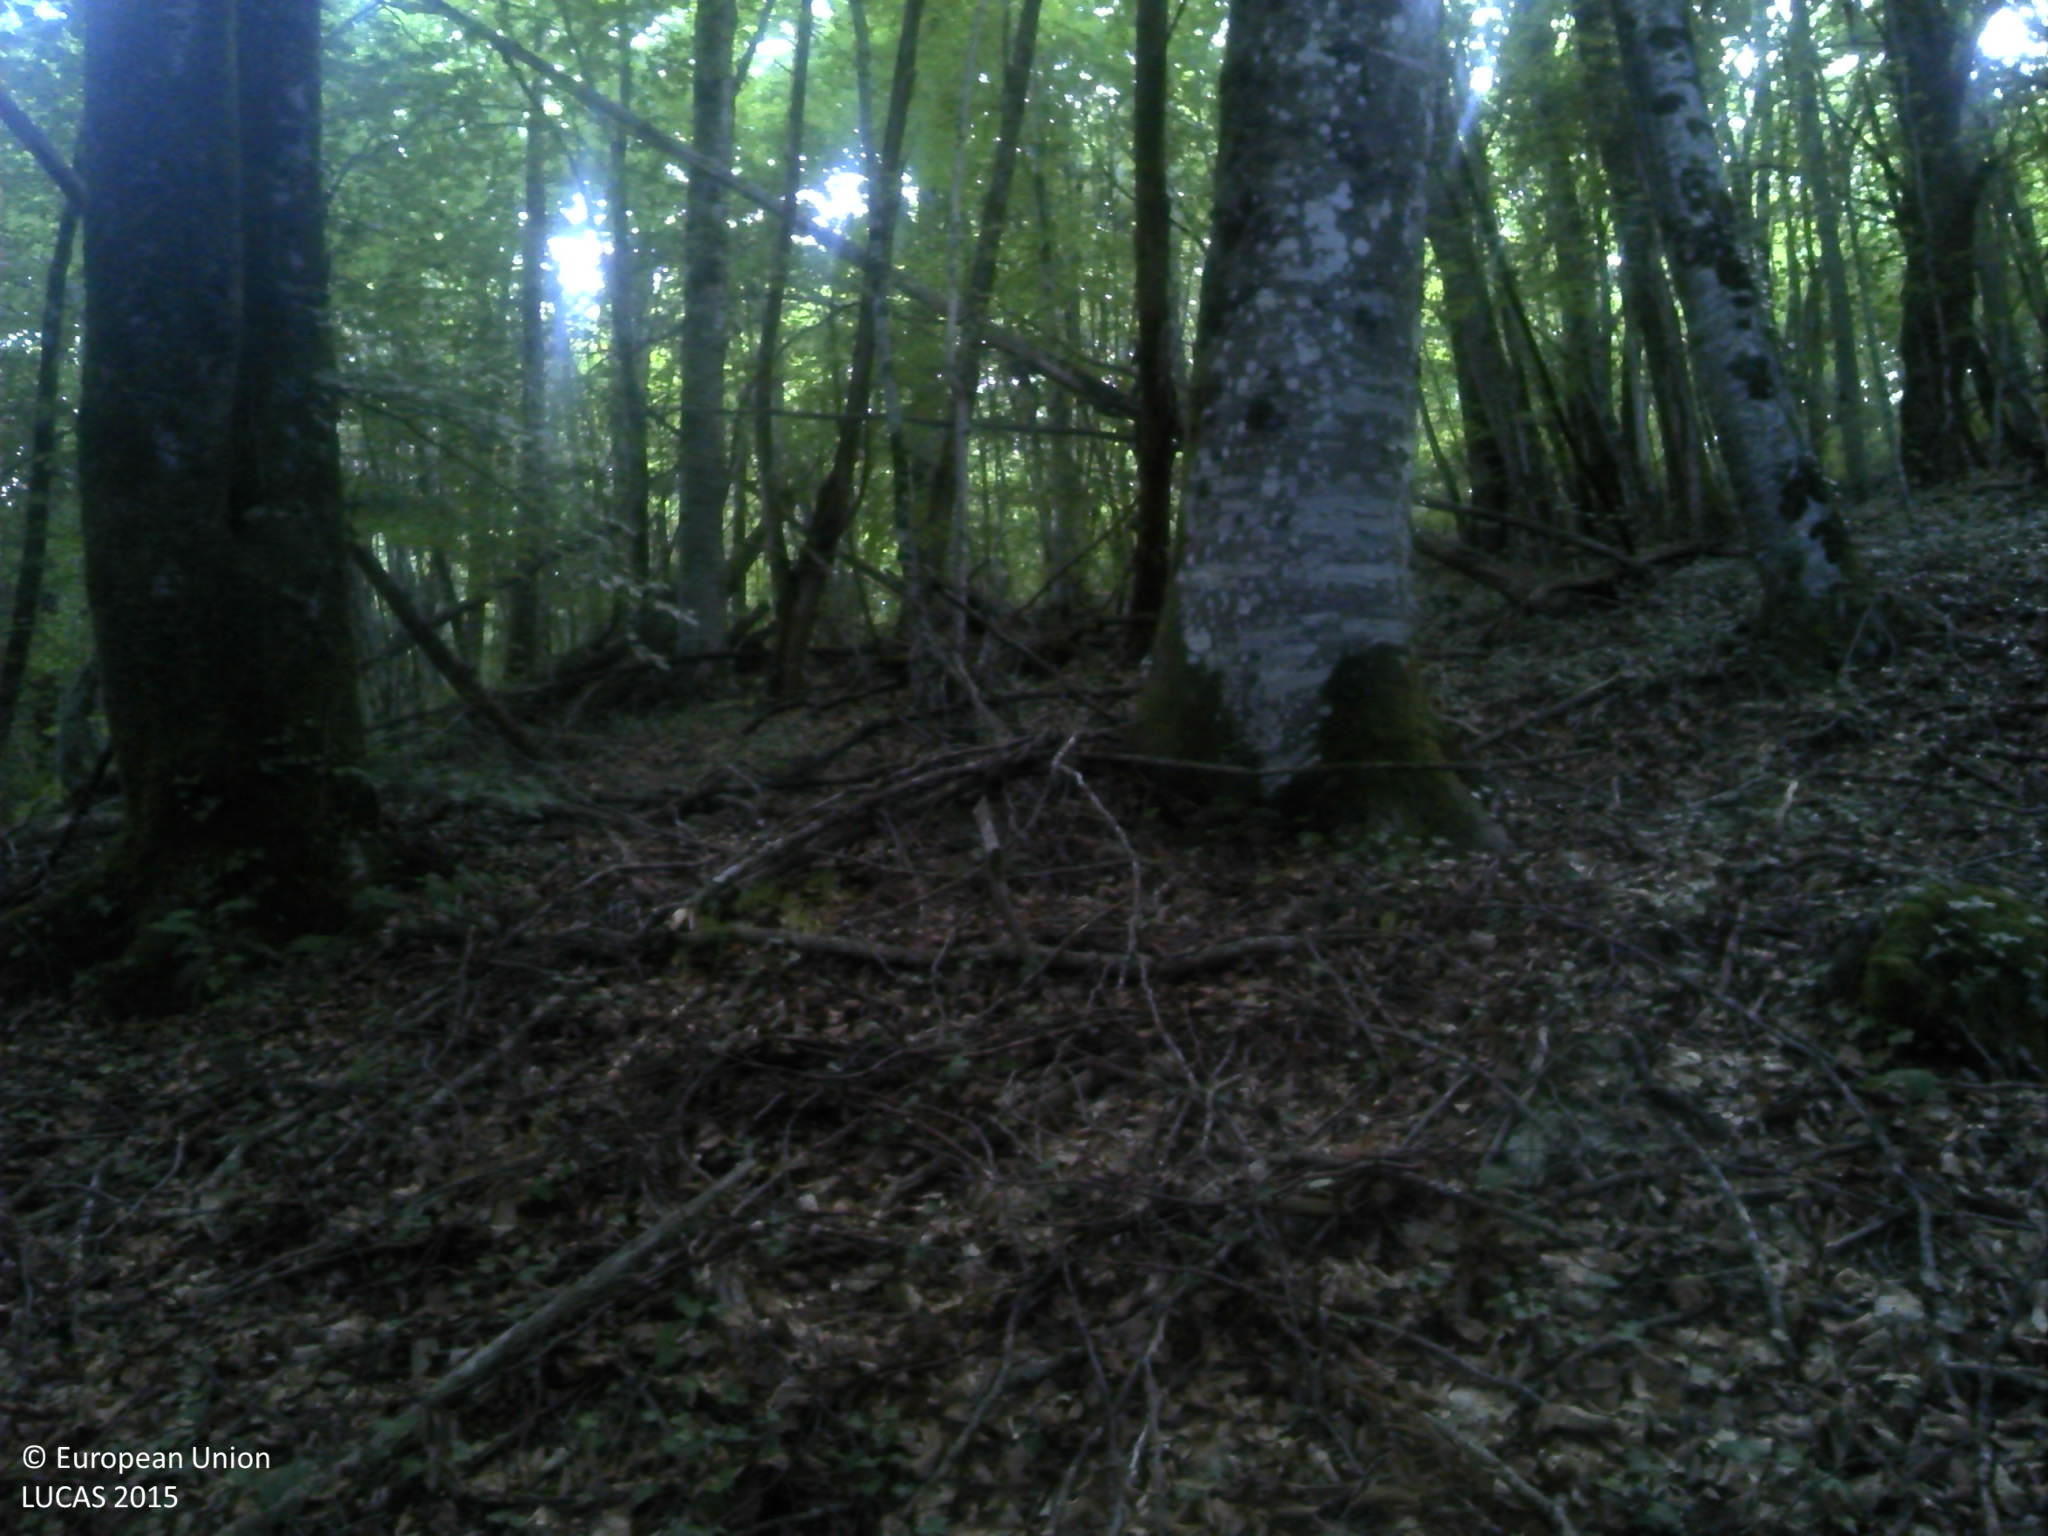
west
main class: Woodland
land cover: Broadleaved woodland
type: acidophilous oak and oak-birch forest
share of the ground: > 75 %
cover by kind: broadleaved forest trees 55 %, unconsolidated bare surface 30 %, lichens and mosses 10 %, herbaceous plants 5 %
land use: Forestry
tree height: > 5 m
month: July
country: FR
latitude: 45.2139
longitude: 1.7066
